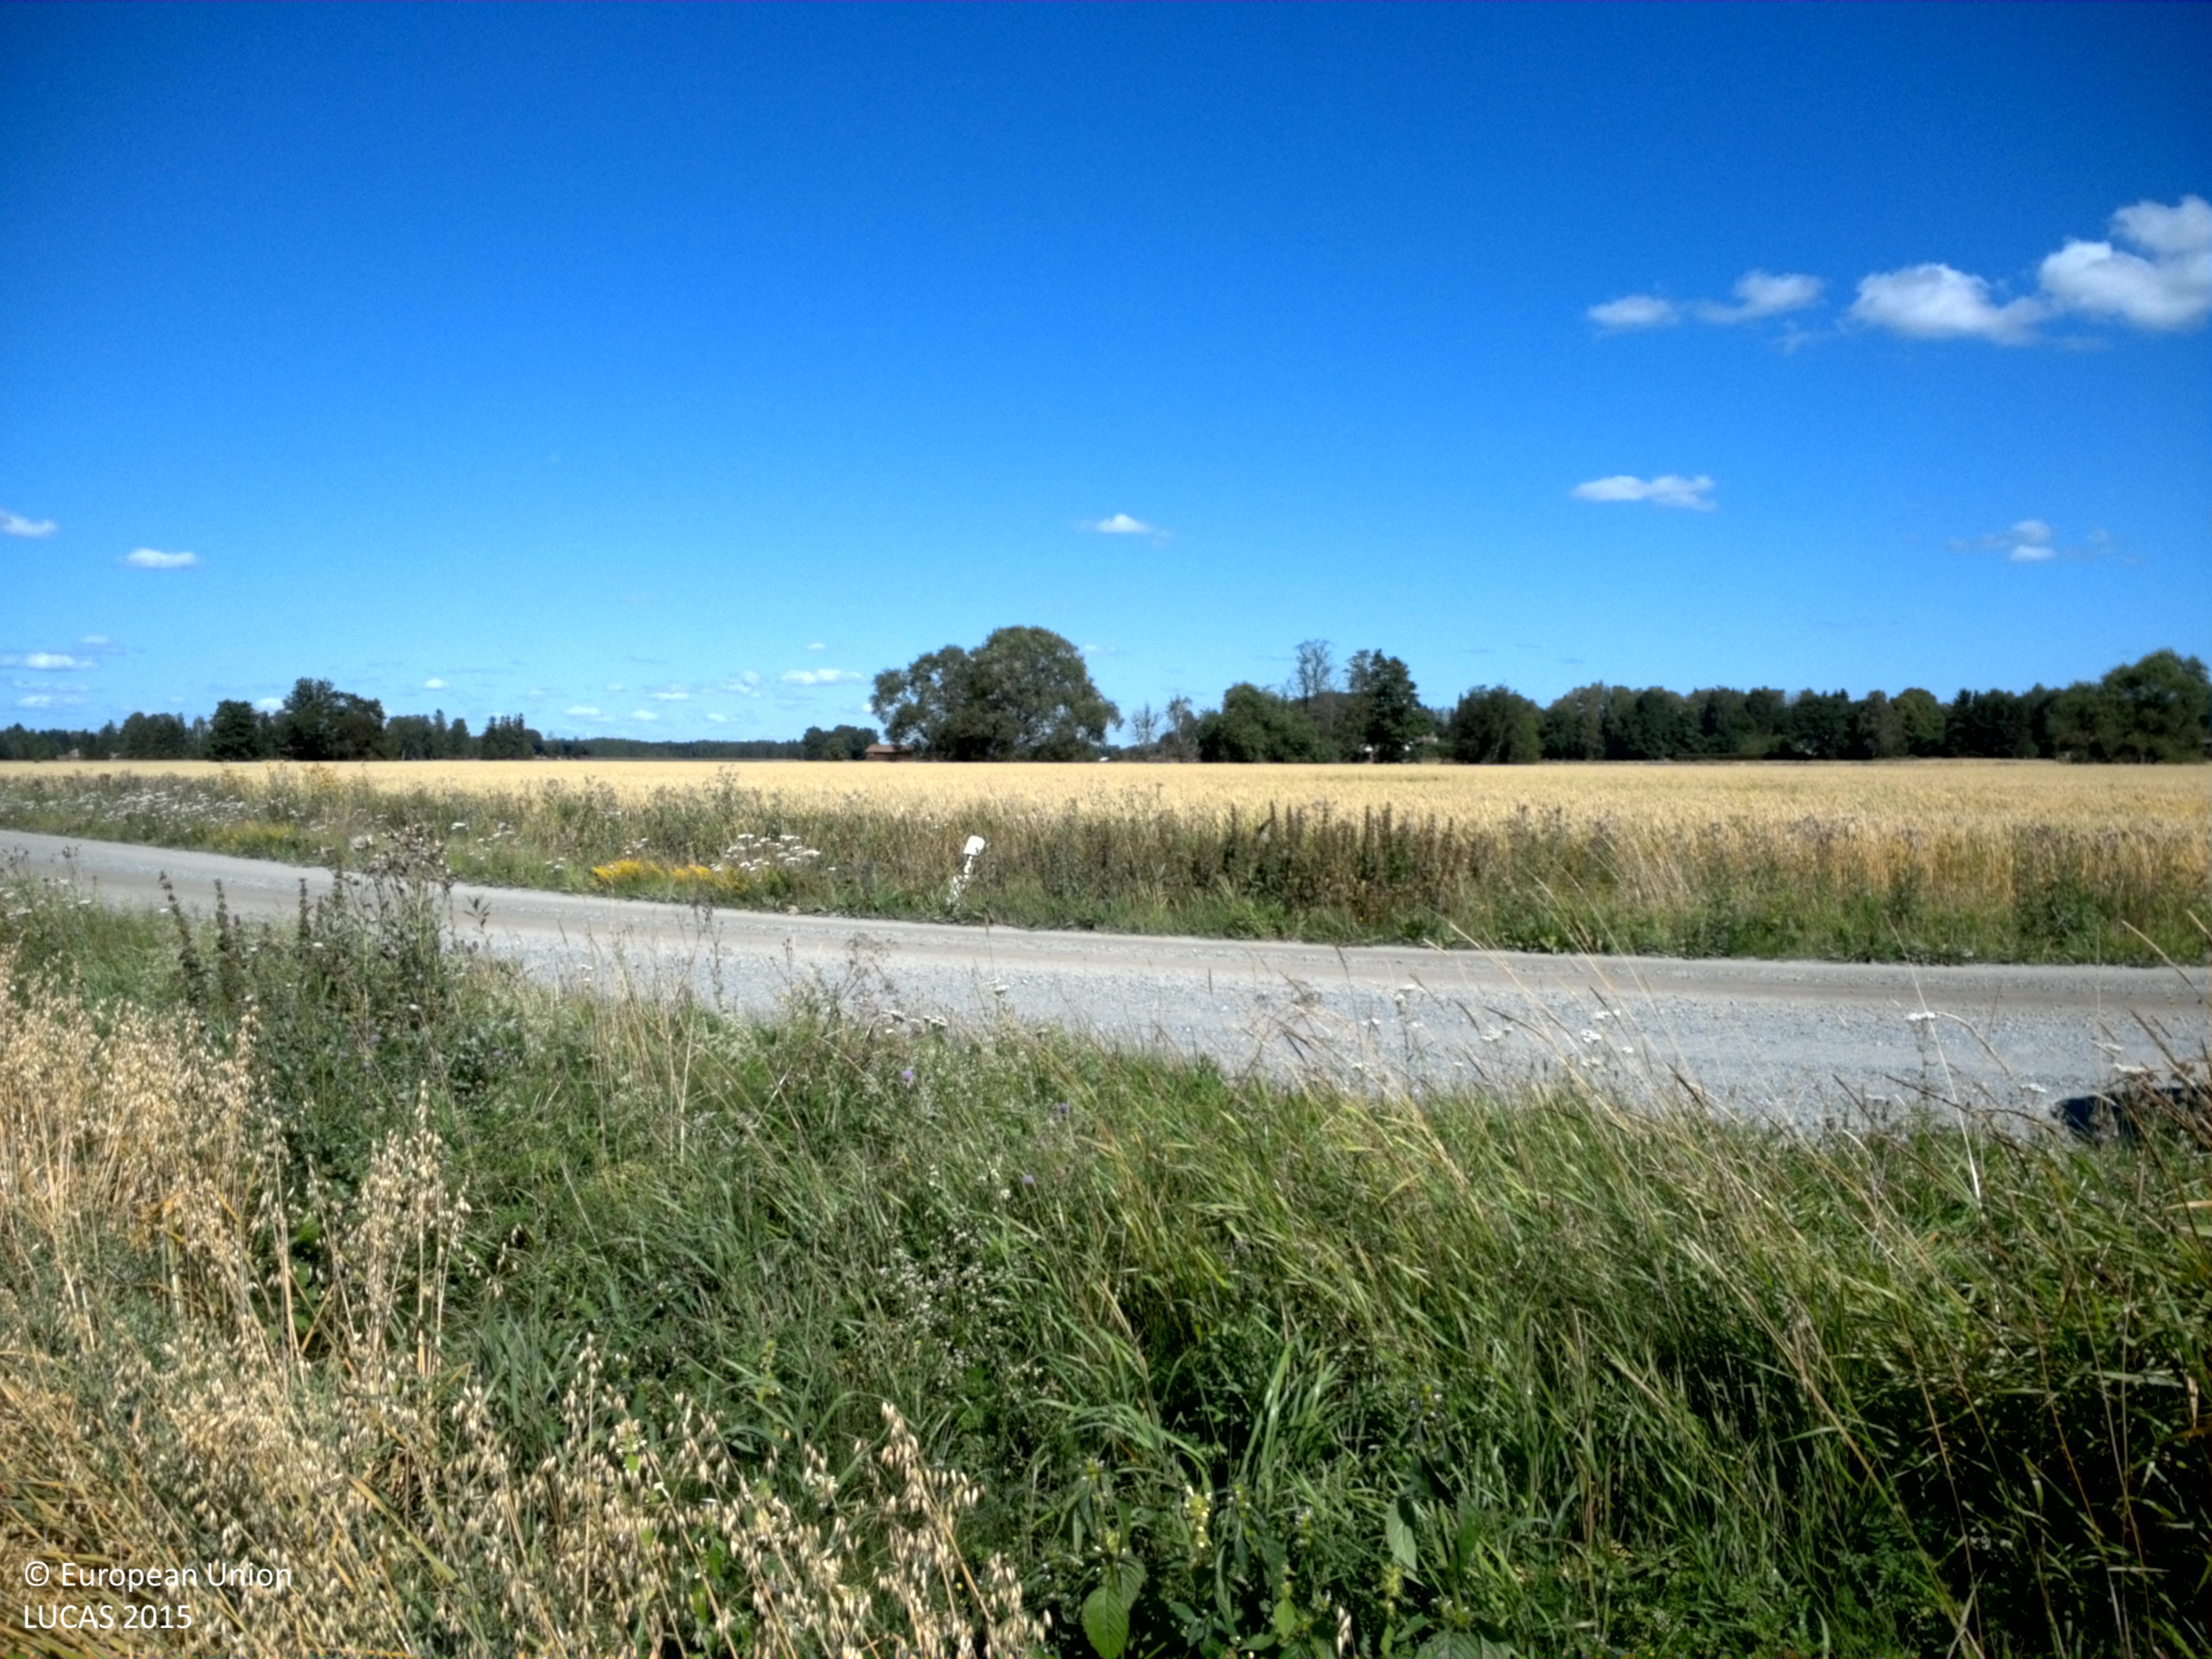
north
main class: Cropland
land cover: Oats
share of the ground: > 75 %
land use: Agriculture (excluding fallow land and kitchen gardens)
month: August
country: SE
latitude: 59.7716
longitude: 16.6340
